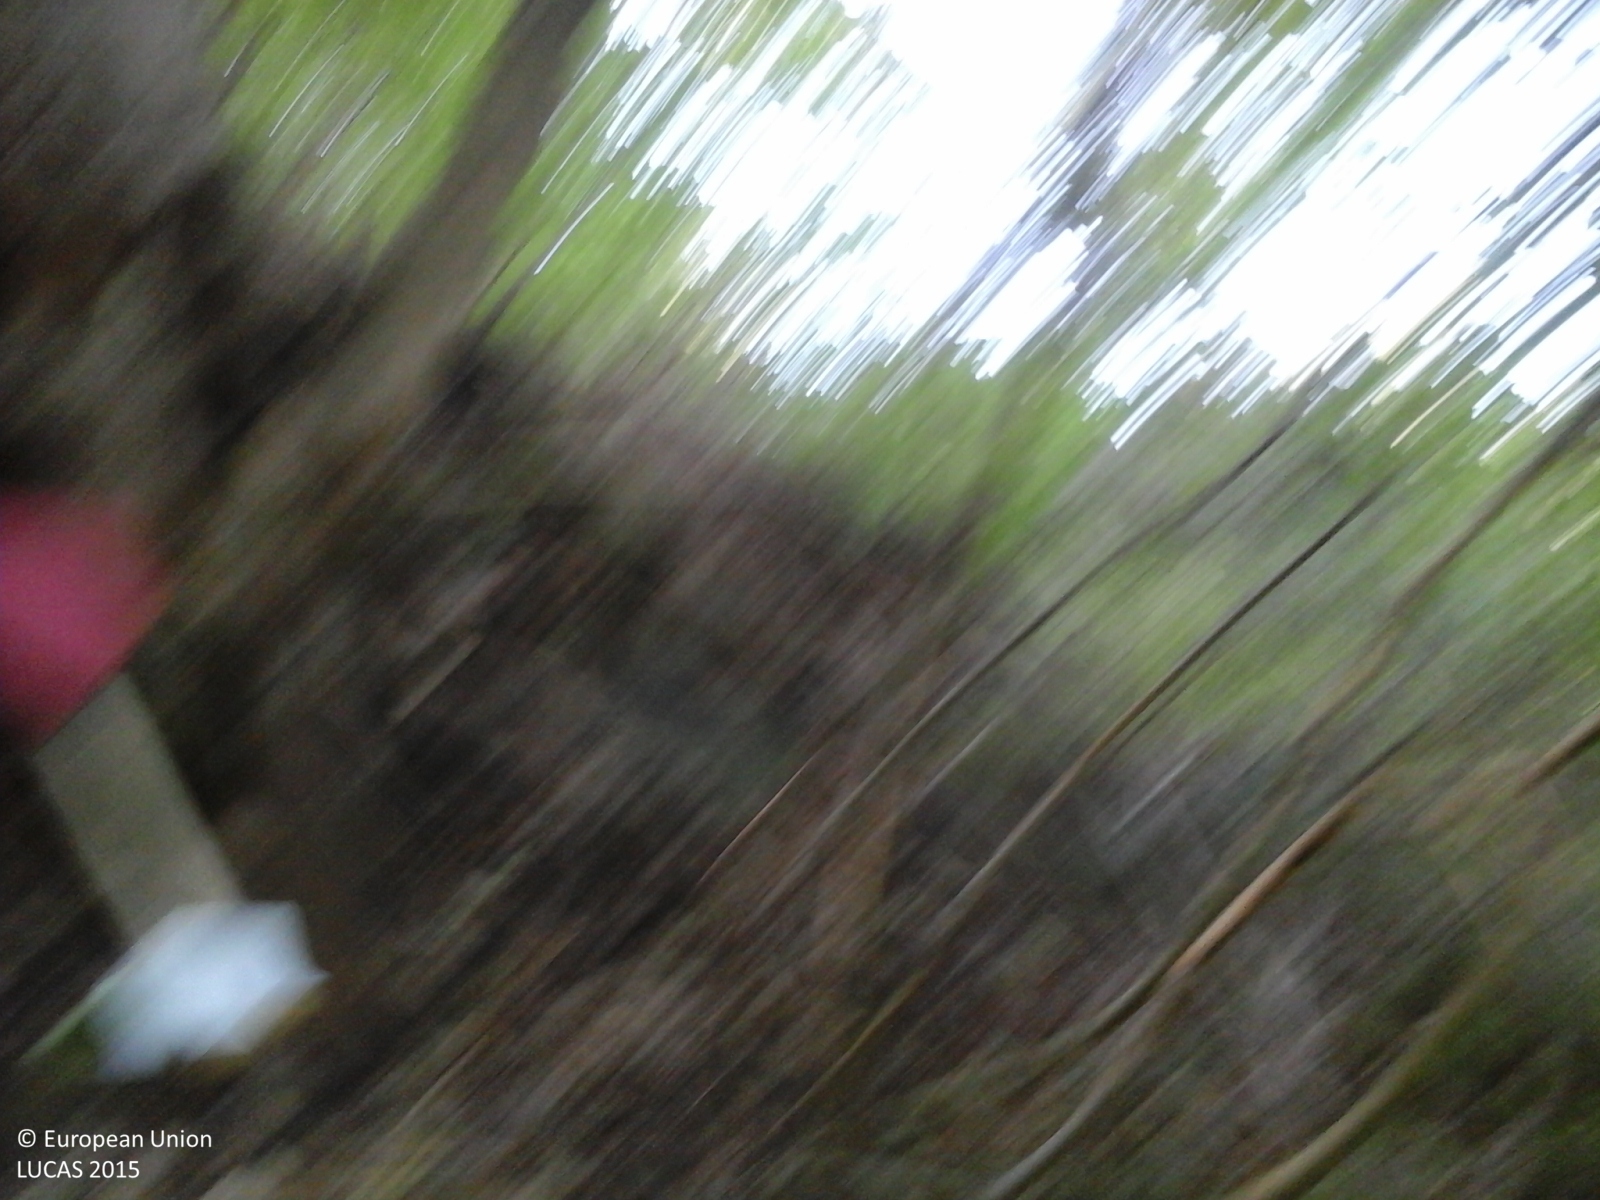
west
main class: Woodland
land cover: Broadleaved woodland
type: thermophilous deciduous forest
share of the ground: > 75 %
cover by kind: broadleaved forest trees 90 %, herbaceous plants 10 %
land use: Semi-natural and natural areas not in use
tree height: > 5 m
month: September
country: IT
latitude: 44.3901
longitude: 8.2589
